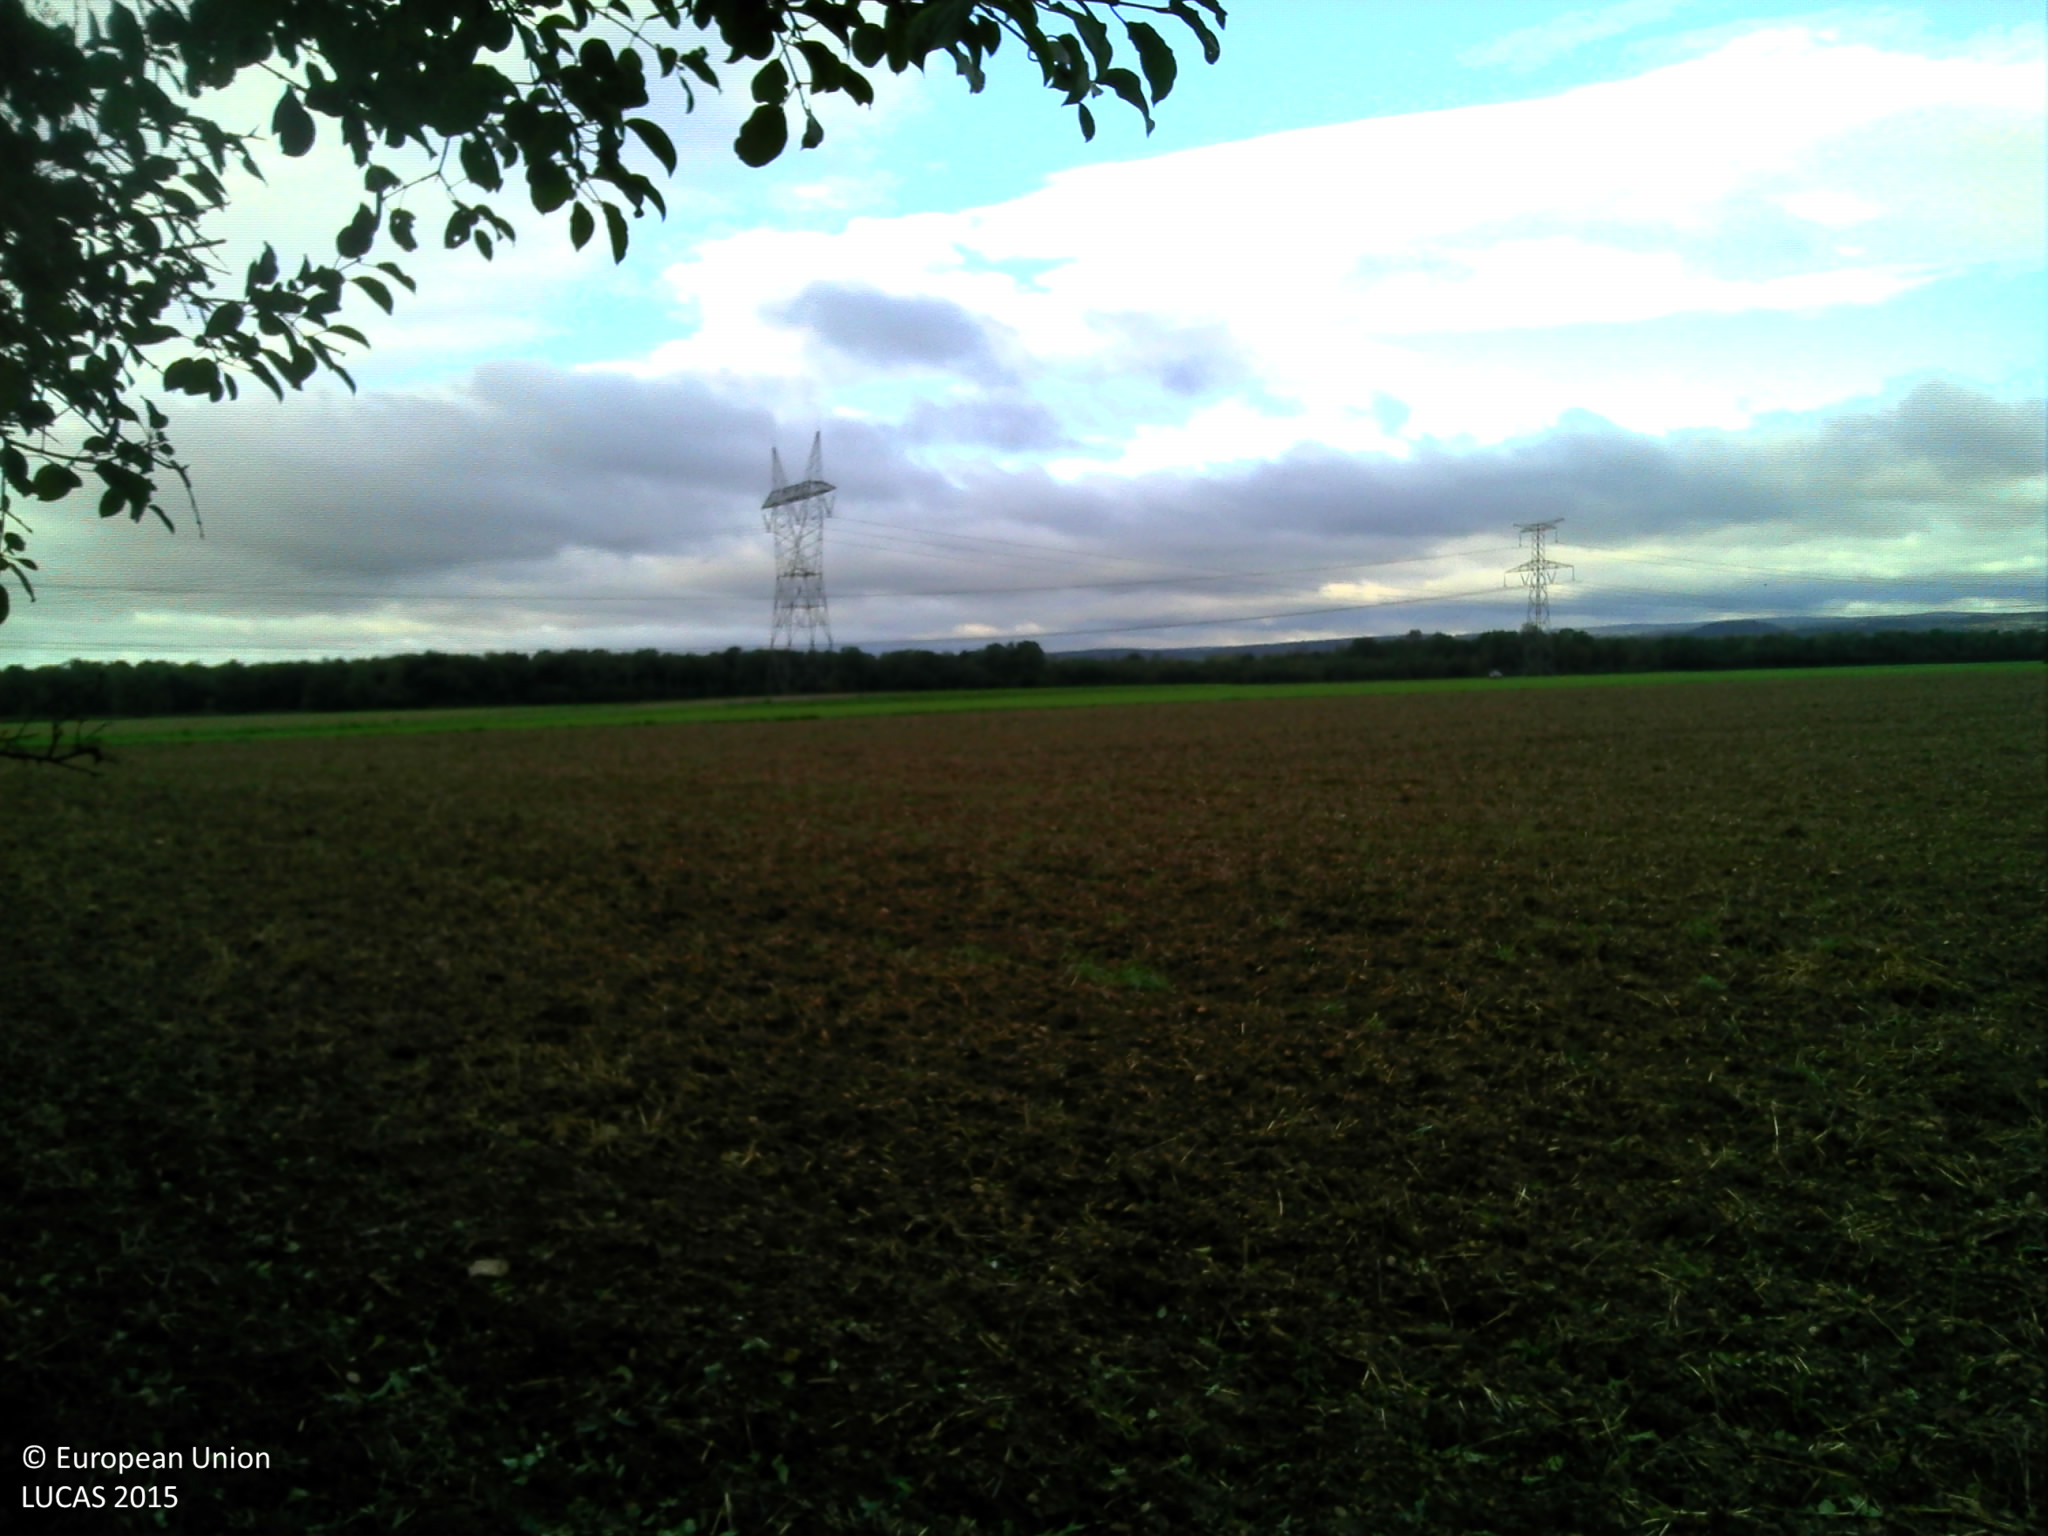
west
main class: Grassland
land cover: Grassland without tree/shrub cover
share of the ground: > 75 %
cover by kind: herbaceous plants 100 %
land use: Agriculture (excluding fallow land and kitchen gardens)
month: September
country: FR
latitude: 47.0814
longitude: 4.9827
